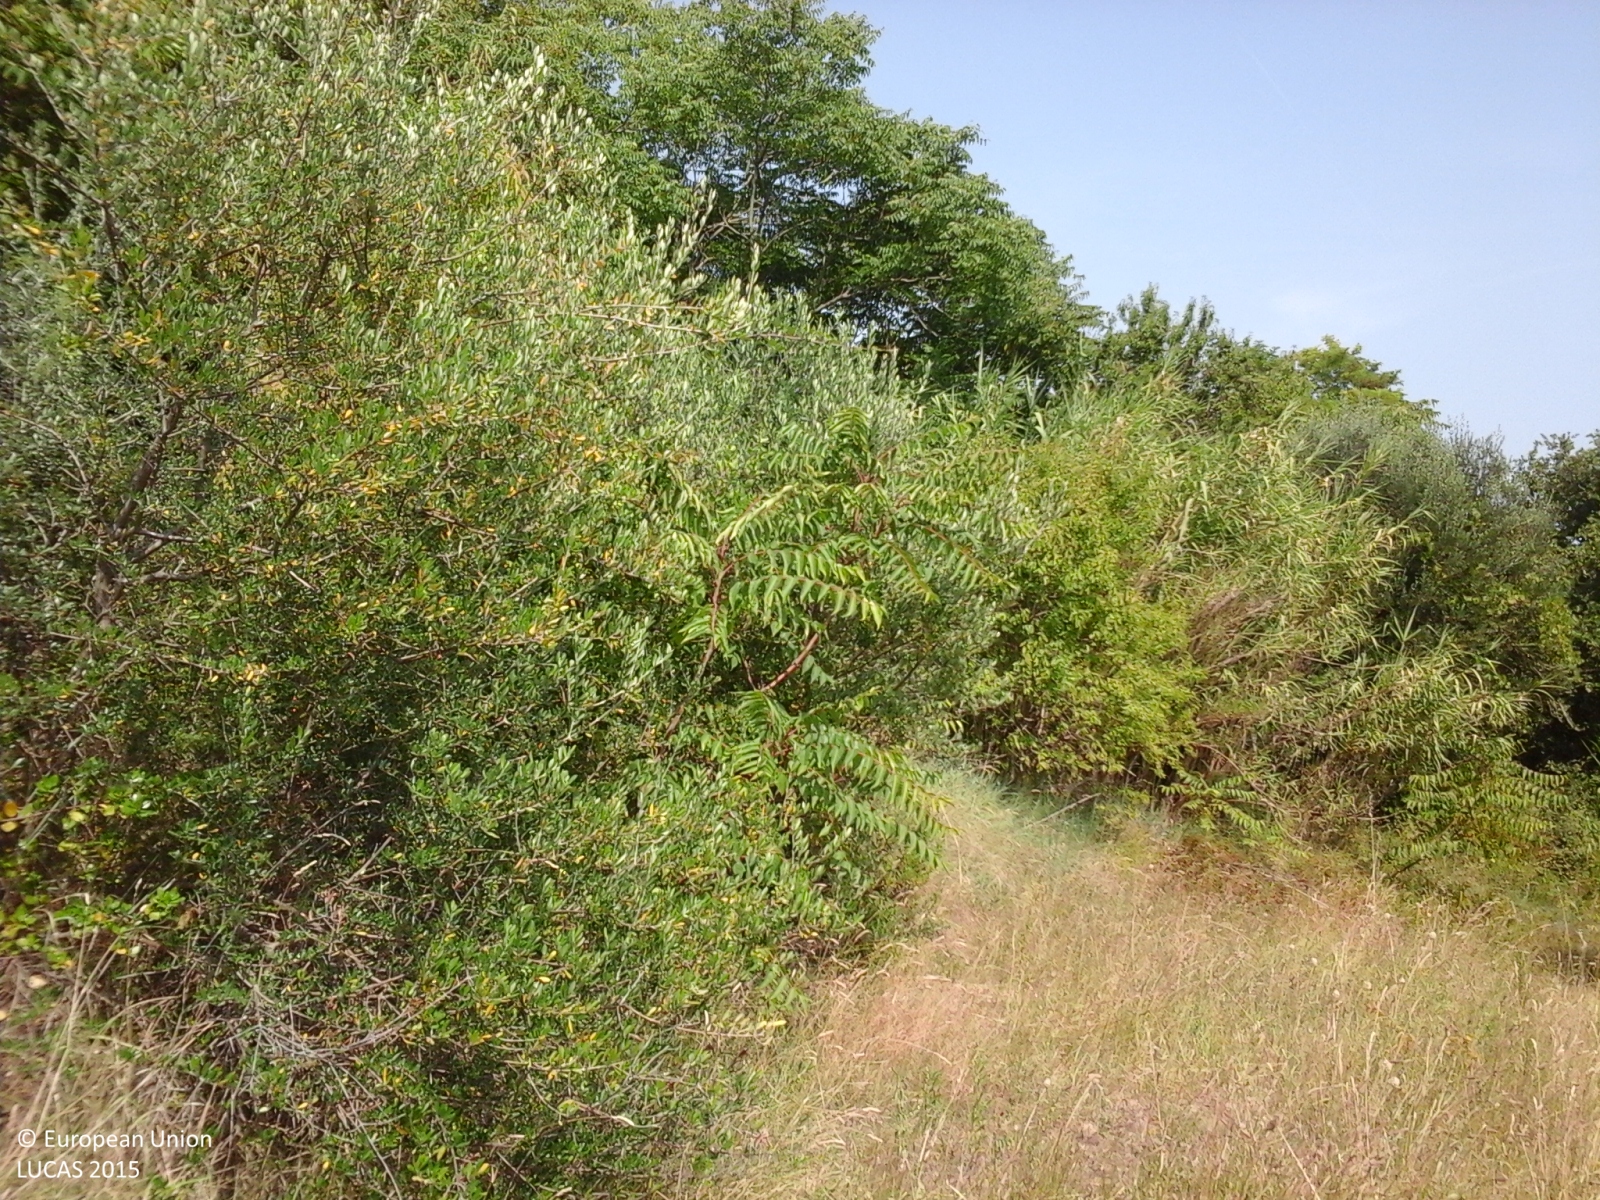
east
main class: Cropland
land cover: Olive groves
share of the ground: 10 - 25 %
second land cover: Grassland without tree/shrub cover
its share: 50 - 75 %
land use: Agriculture (excluding fallow land and kitchen gardens)
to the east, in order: Olive groves; Grassland without tree/shrub cover; Broadleaved woodland; Electric lines; Grassland with sparse tree/shrub cover; Grassland without tree/shrub cover; Maize; Tomatoes; Other fresh vegetables; Grassland without tree/shrub cover; Olive groves; Tracks; Fences; Olive groves; Single bushes/trees; Maize; Tomatoes; Other fresh vegetables; Pine dominated coniferous woodland; Olive groves; Fences; Grass margins; Paved roads, cycling and walking lanes; Grassland without tree/shrub cover
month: July
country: IT
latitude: 43.0515
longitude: 13.8326
